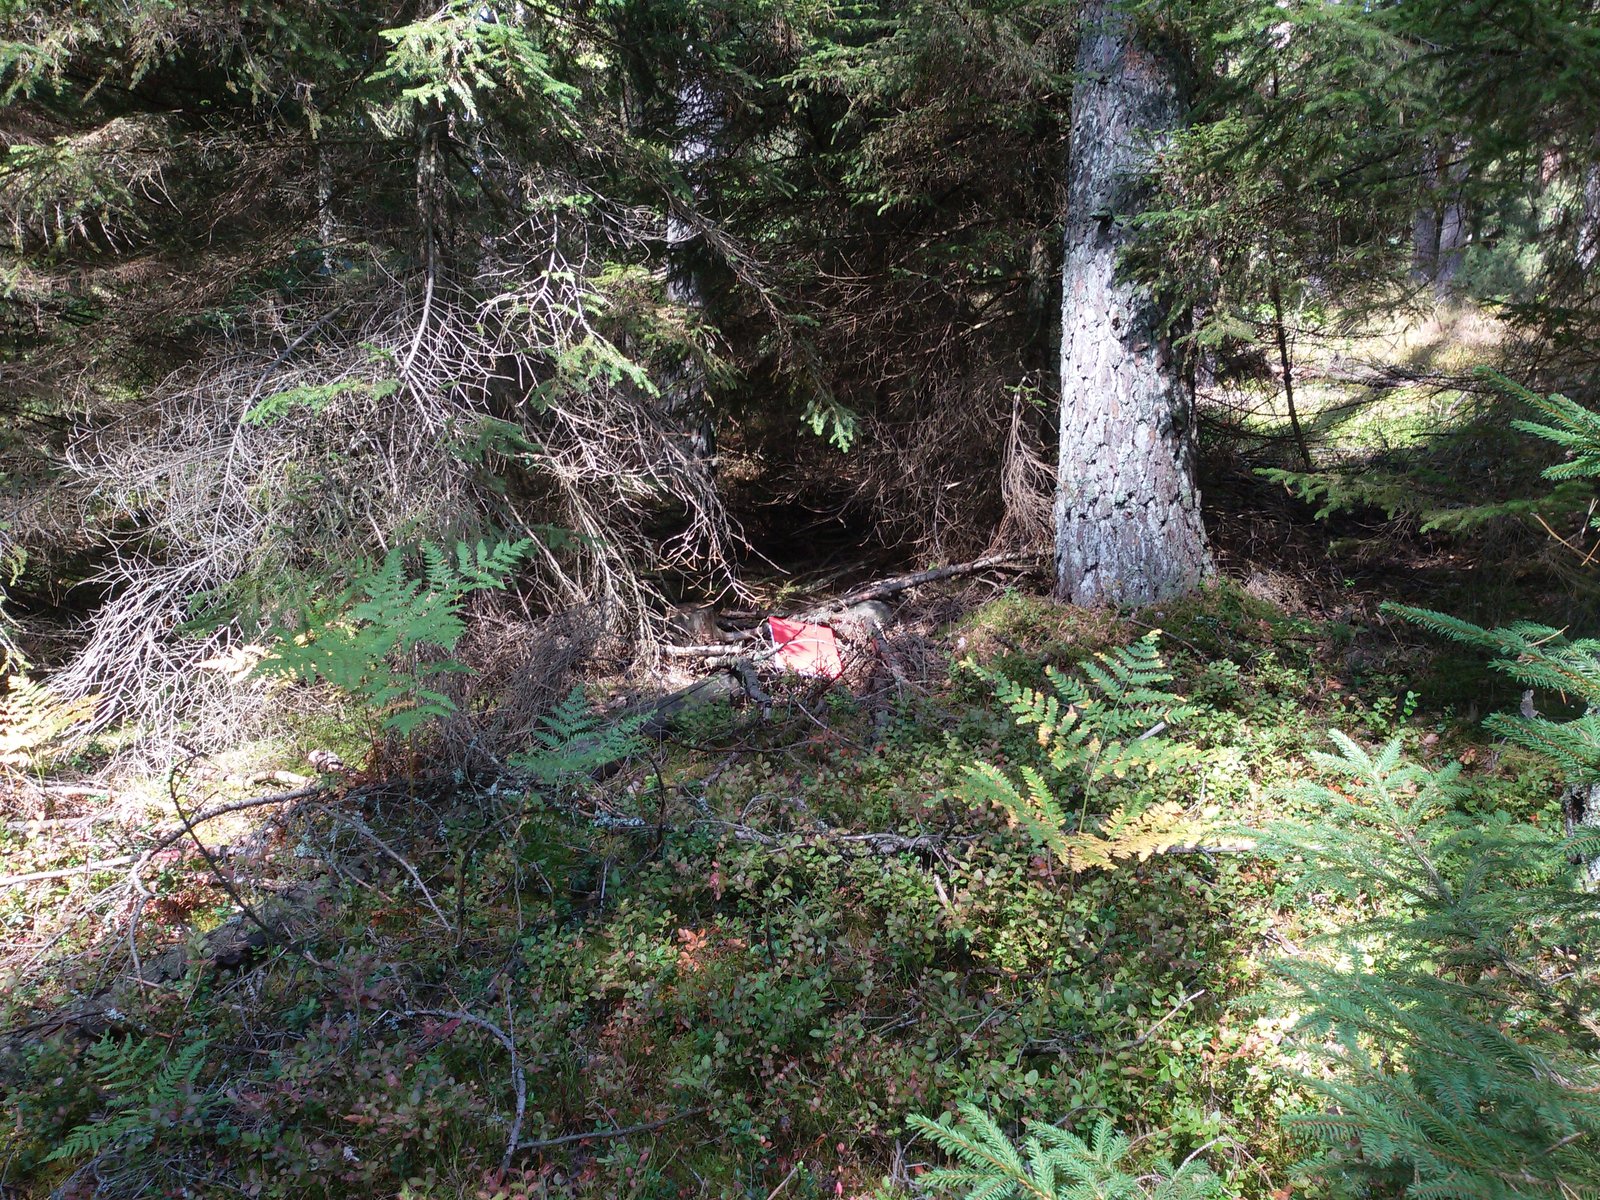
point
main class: Woodland
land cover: Pine dominated coniferous woodland
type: hemiboreal forest and nemoral coniferous forest and mixed broadleaved-coniferous forest
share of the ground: > 75 %
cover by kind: coniferous forest trees 75 %, shrubs 10 %, broadleaved forest trees 5 %, lichens and mosses 5 %, unconsolidated bare surface 5 %
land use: Forestry
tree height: > 5 m
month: August
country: PL
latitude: 53.8750
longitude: 17.1735
